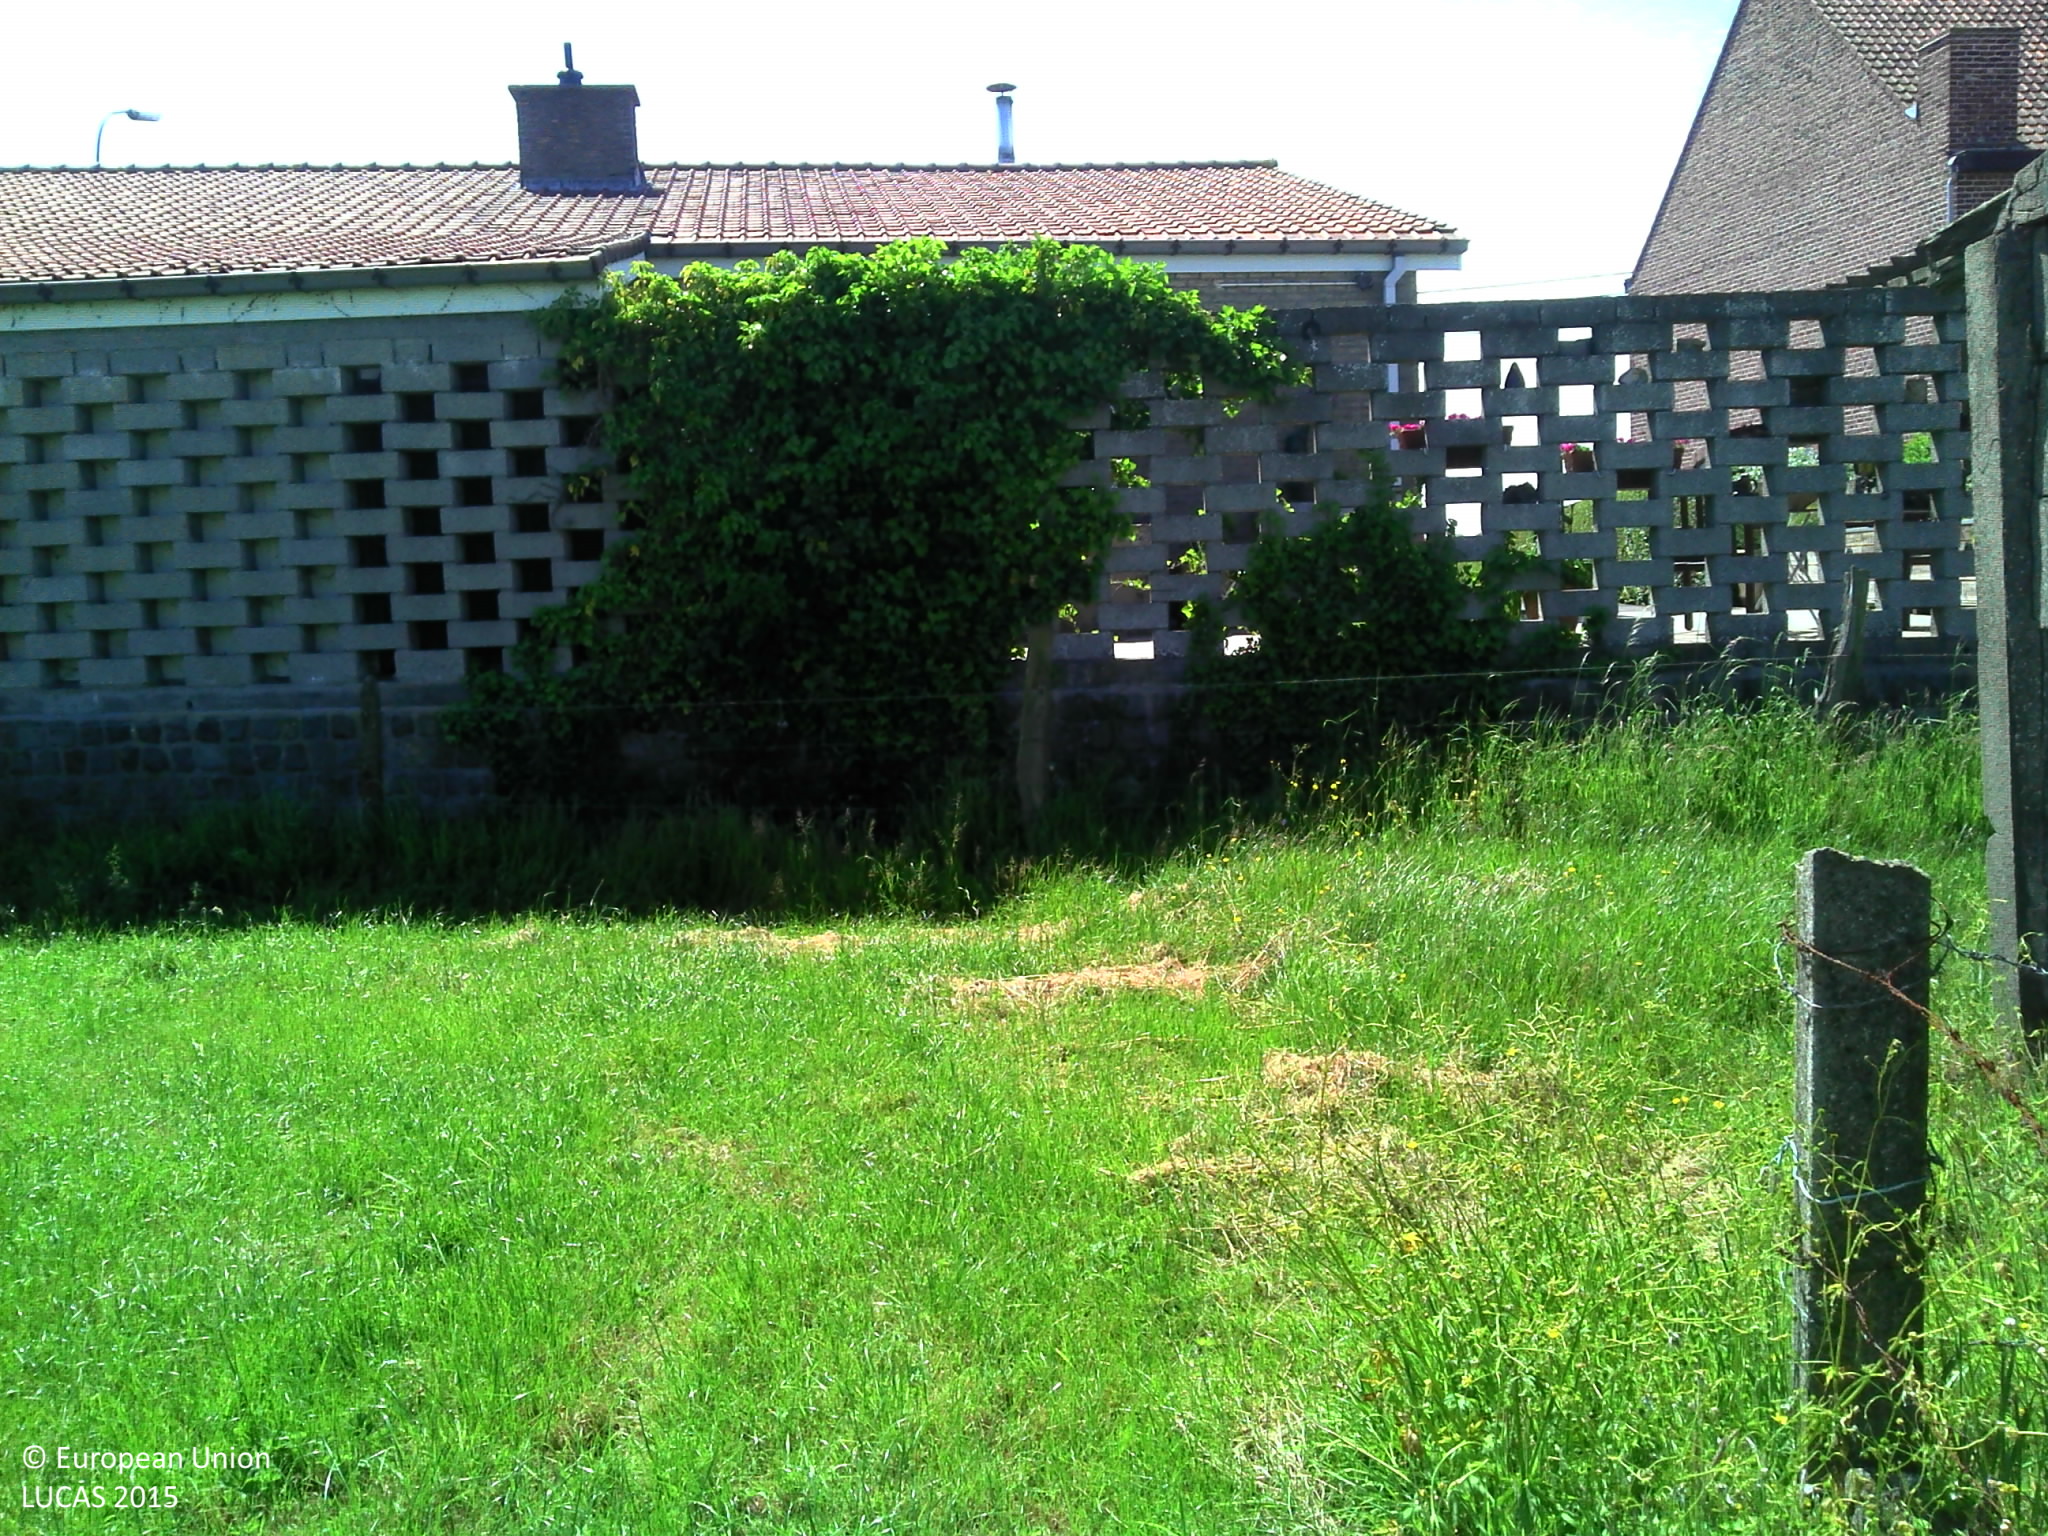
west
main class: Grassland
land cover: Grassland without tree/shrub cover
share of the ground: > 75 %
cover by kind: herbaceous plants 100 %
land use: Semi-natural and natural areas not in use
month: June
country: BE
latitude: 50.8186
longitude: 3.0206
